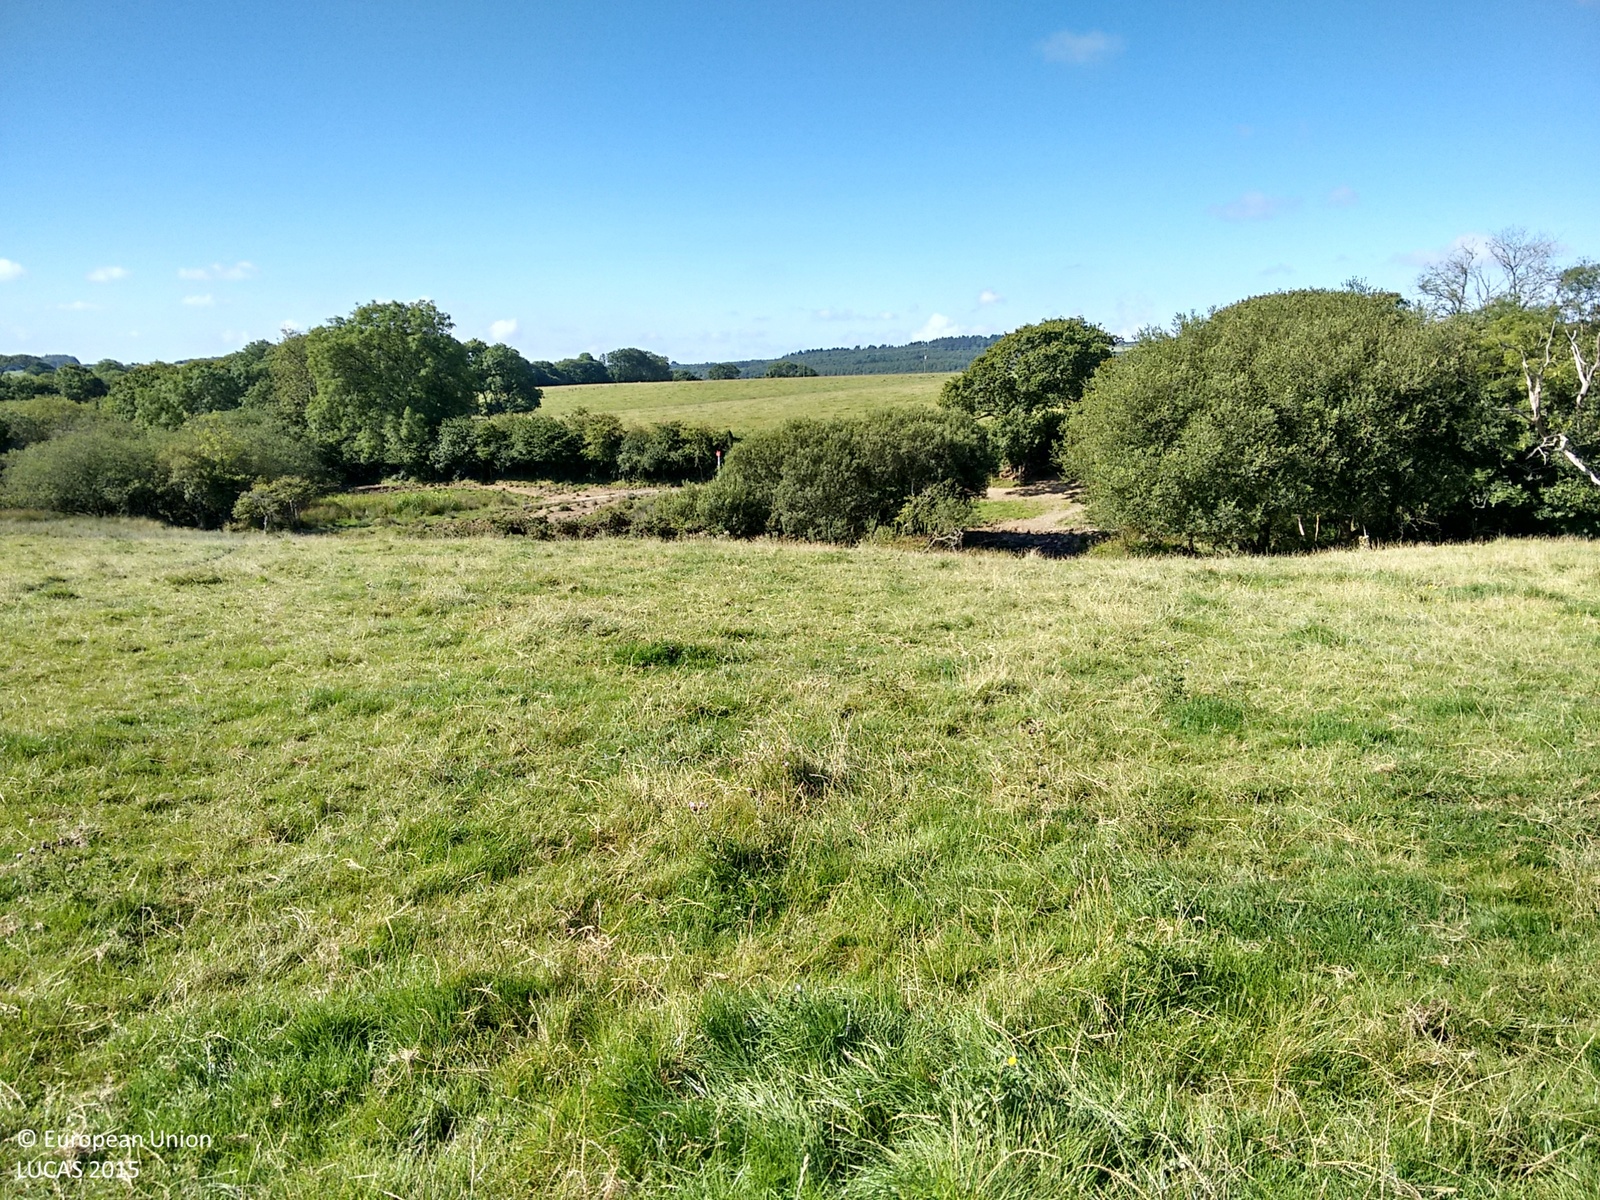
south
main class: Grassland
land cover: Grassland without tree/shrub cover
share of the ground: > 75 %
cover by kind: herbaceous plants 100 %
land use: Agriculture (excluding fallow land and kitchen gardens)
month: August
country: GB
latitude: 51.7443
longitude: -4.8725
